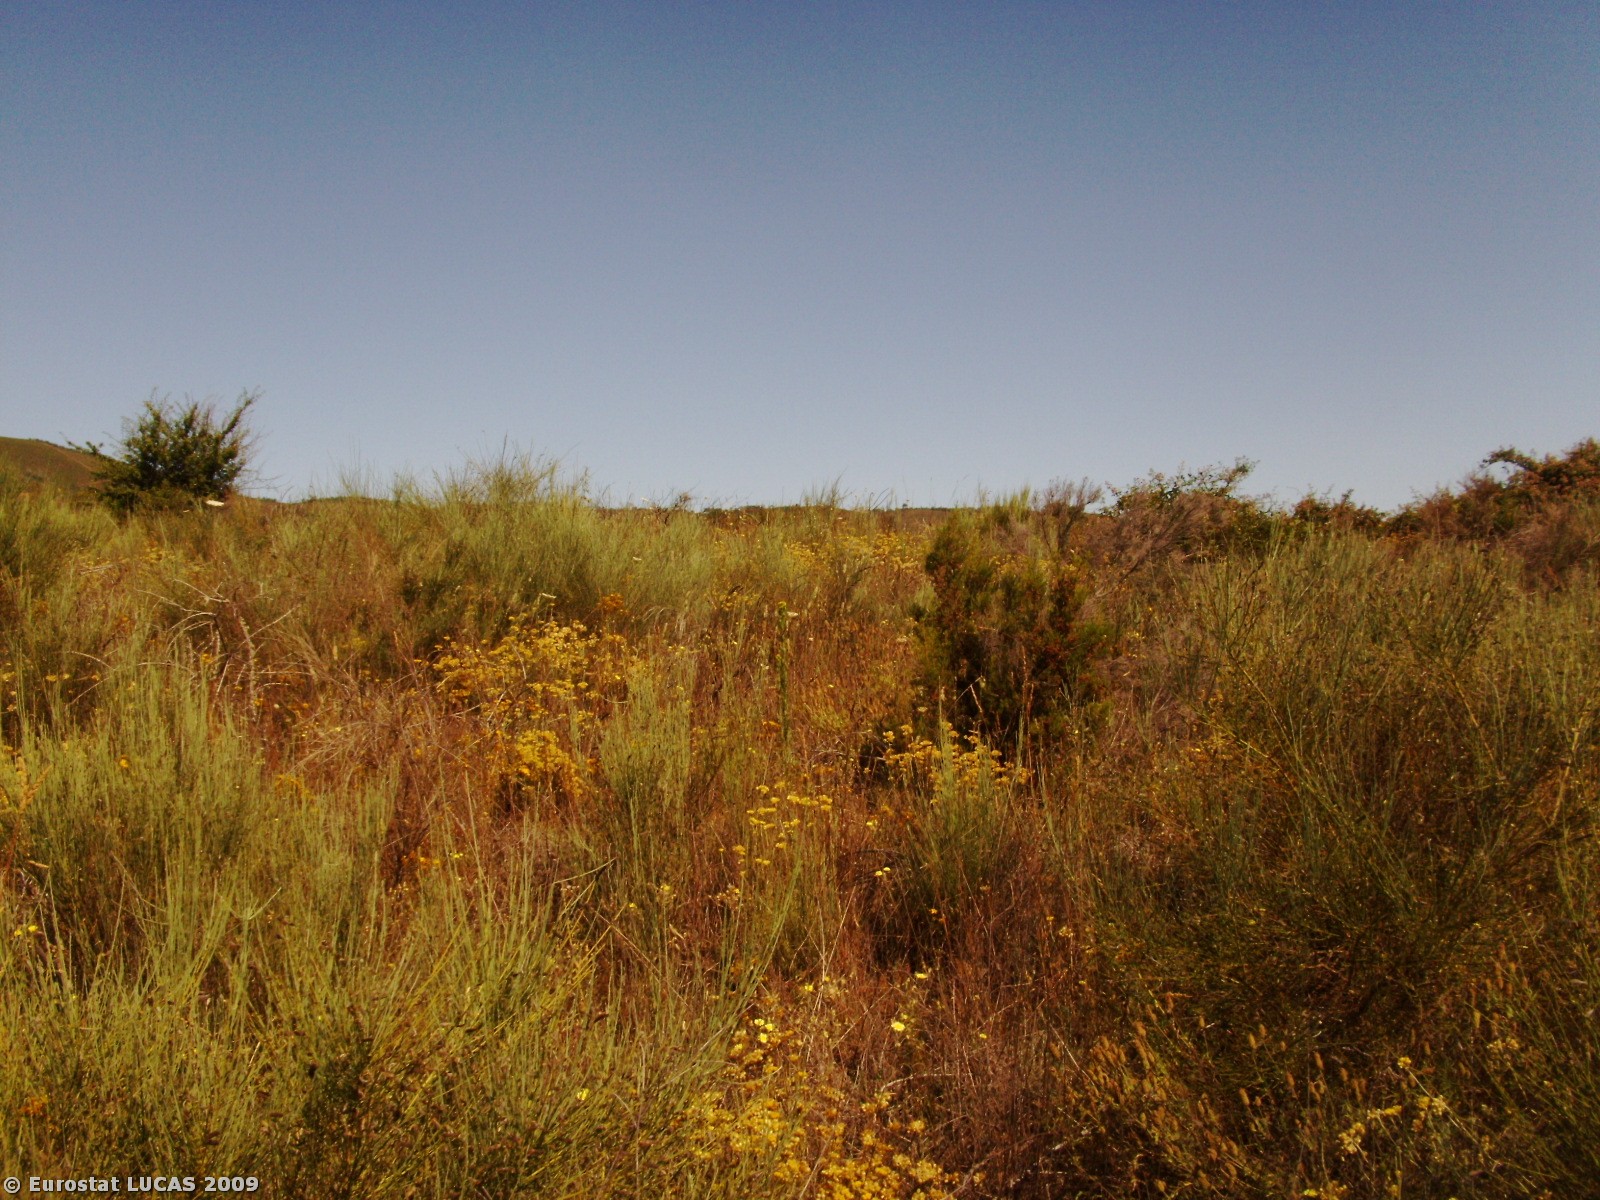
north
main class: Shrubland
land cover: Shrubland without tree cover
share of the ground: > 75 %
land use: Fallow land
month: June
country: PT
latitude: 40.1461
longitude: -7.5613
